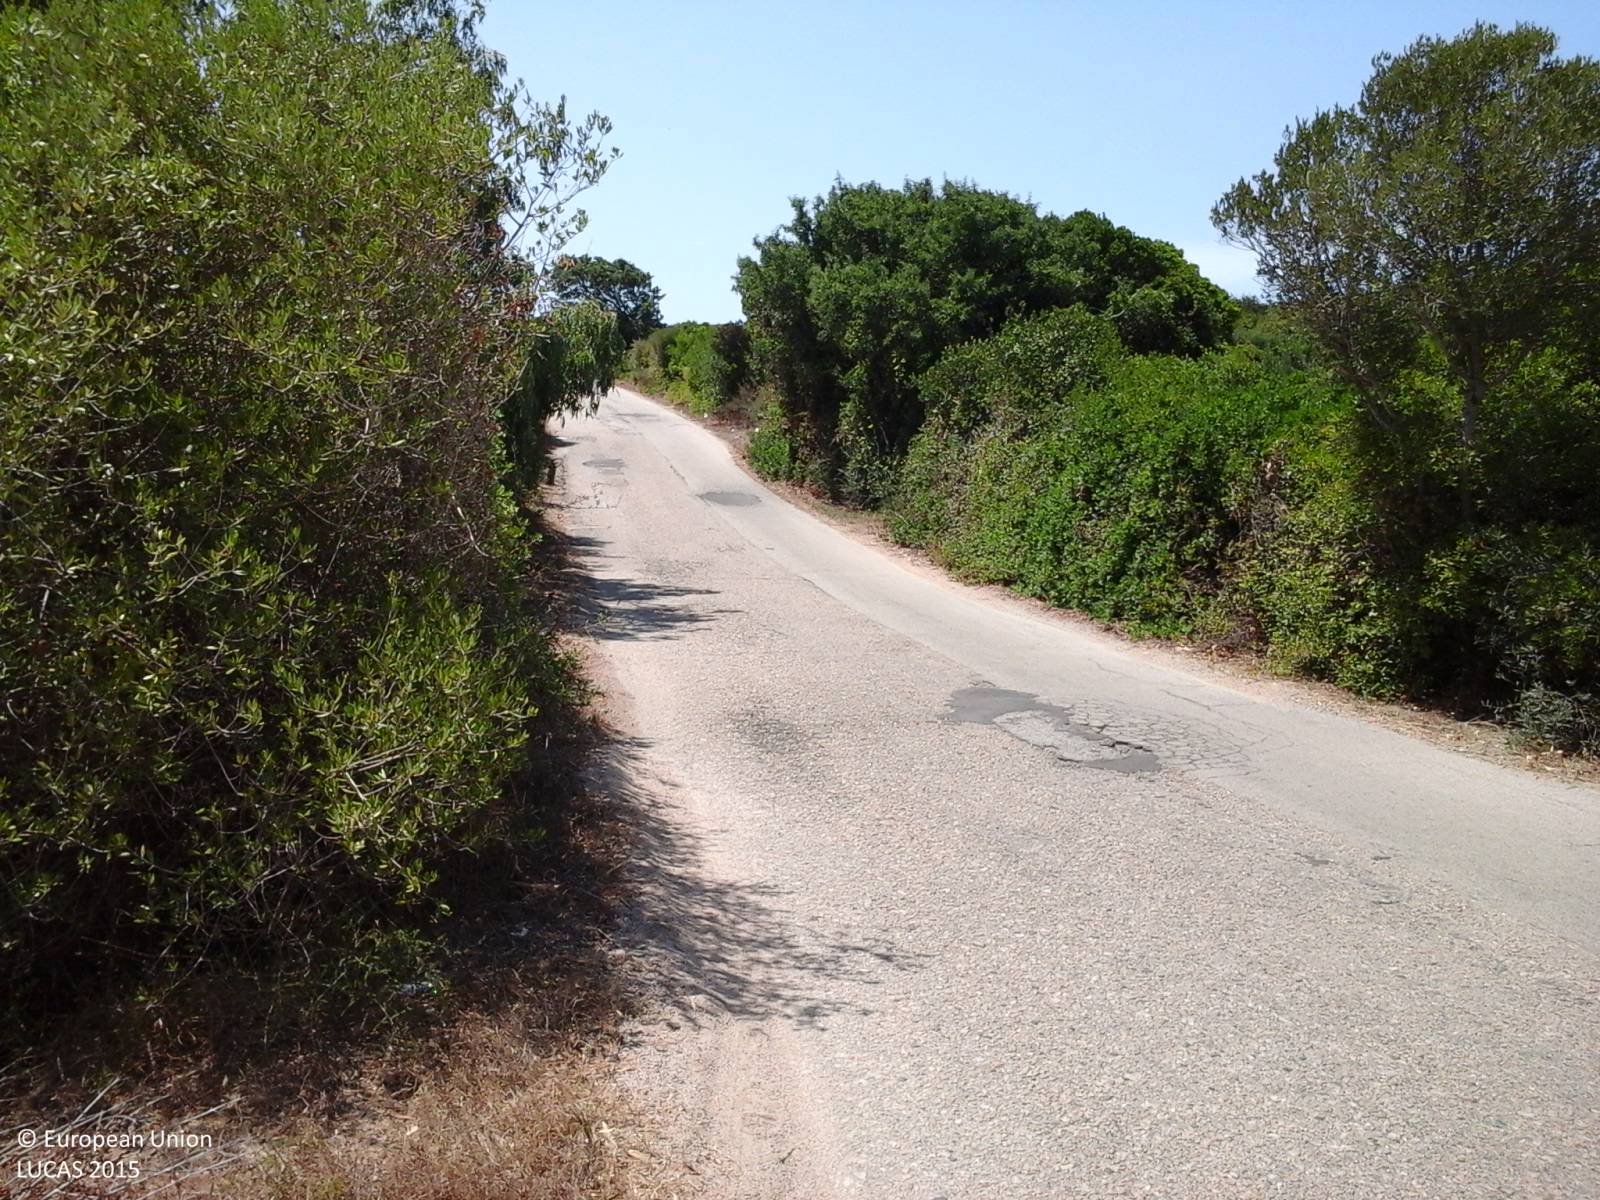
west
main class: Shrubland
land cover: Shrubland with sparse tree cover
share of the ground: > 75 %
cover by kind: shrubs 60 %, herbaceous plants 35 %, broadleaved forest trees 5 %
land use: Semi-natural and natural areas not in use
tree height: > 5 m
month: July
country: IT
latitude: 41.2414
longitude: 9.2278
